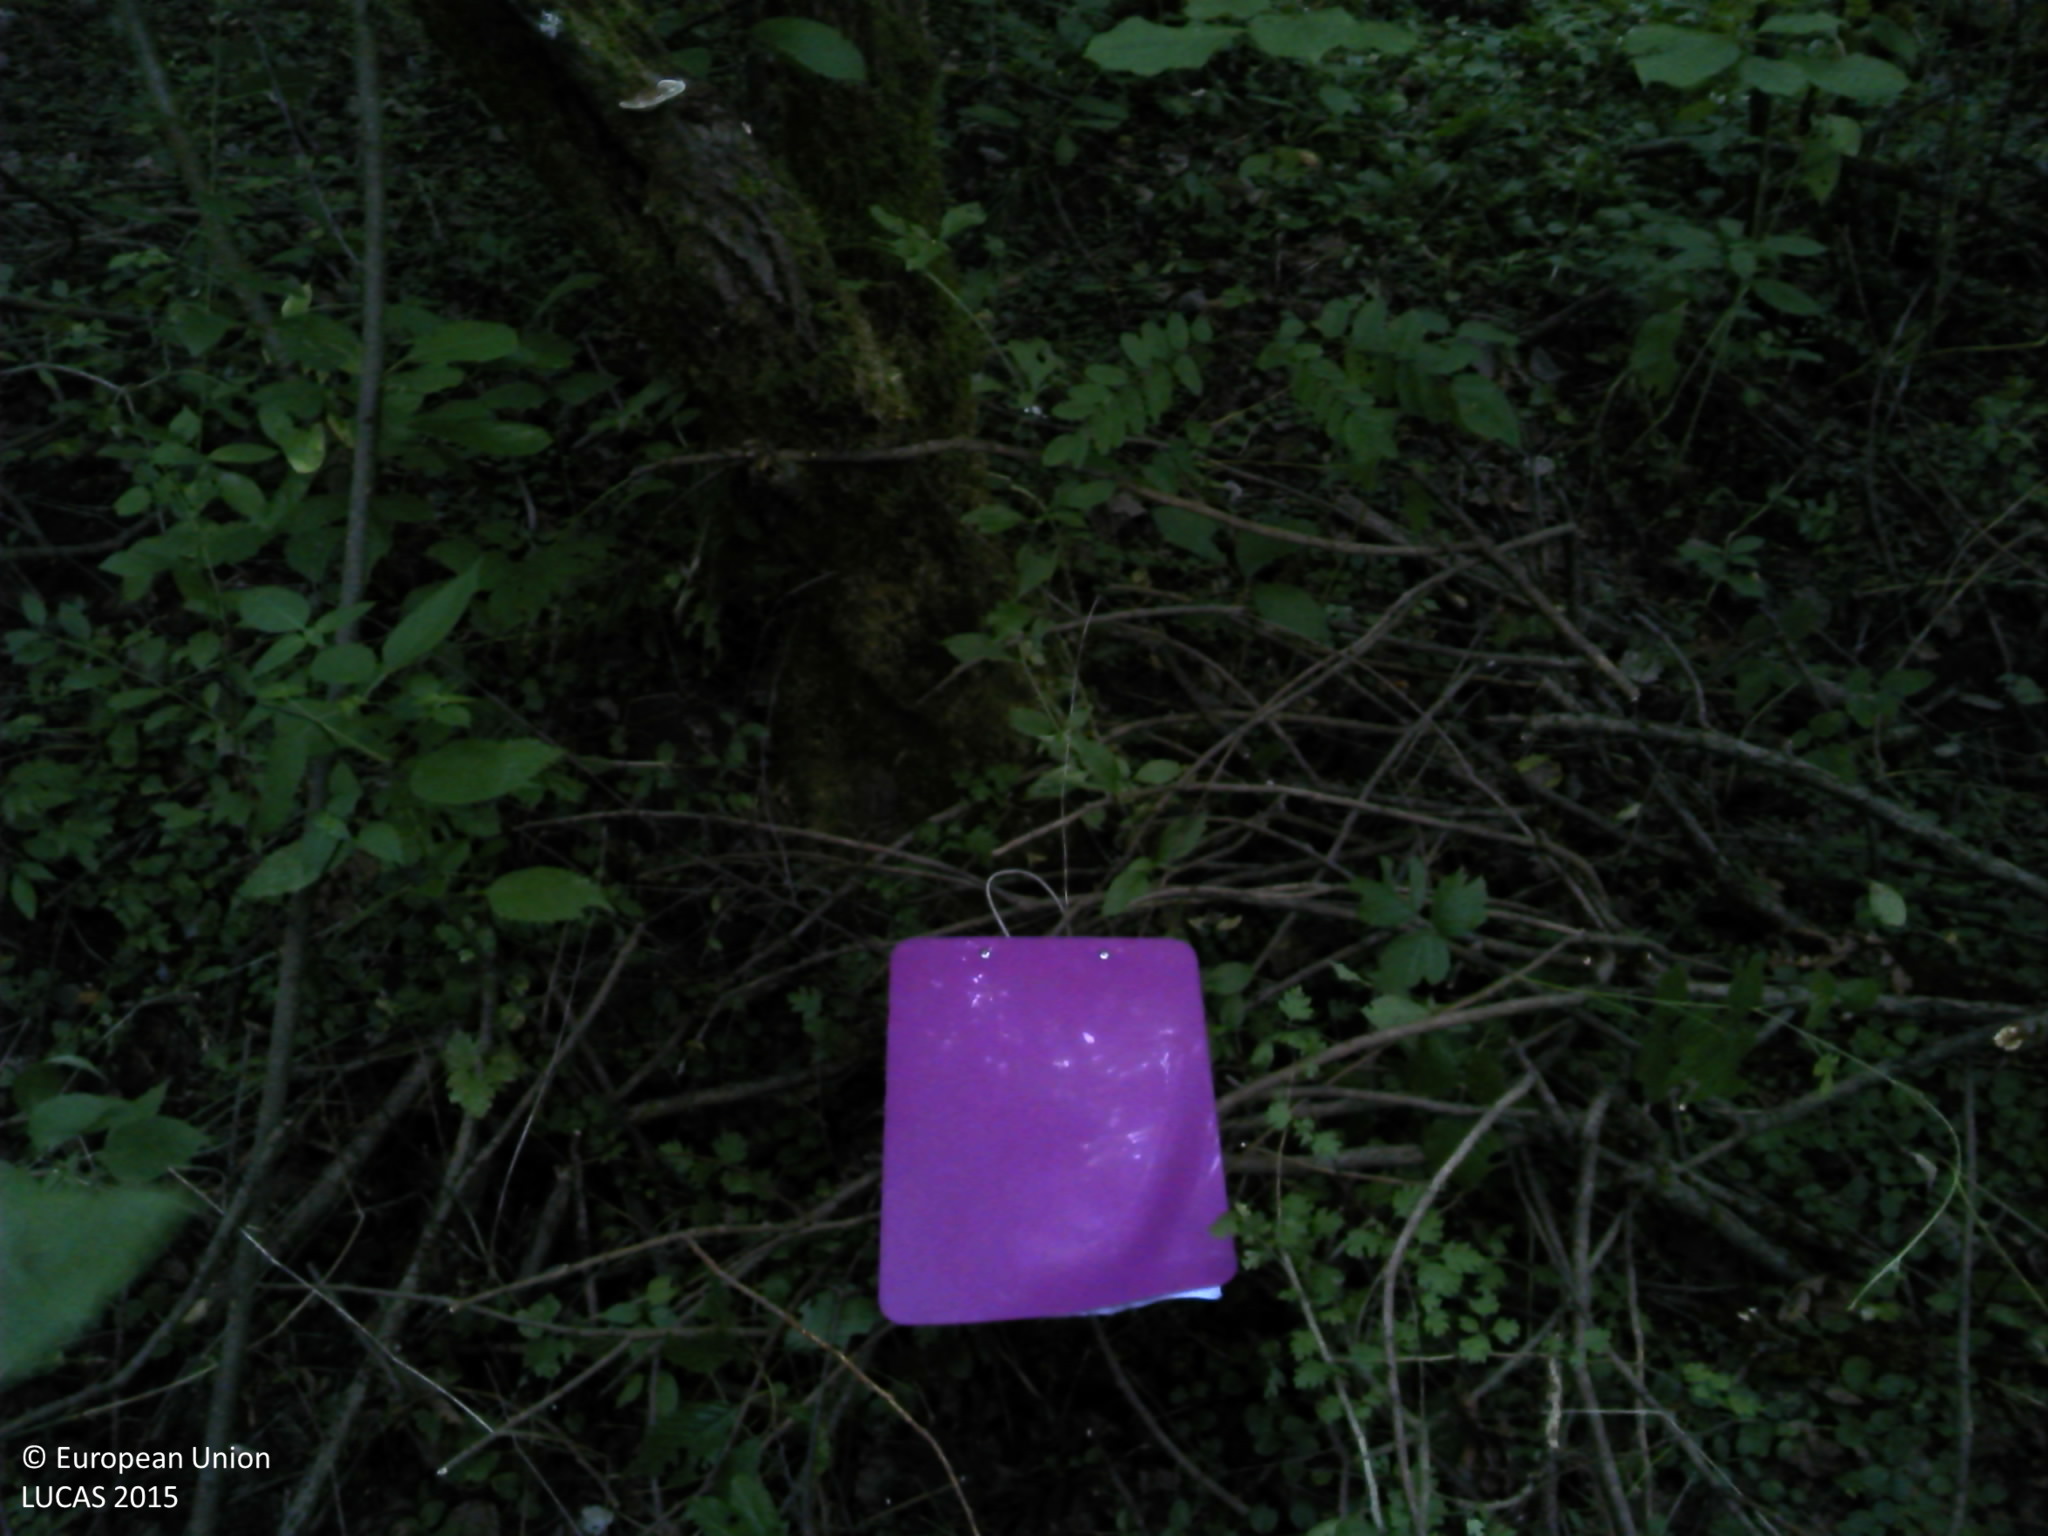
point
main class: Shrubland
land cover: Shrubland with sparse tree cover
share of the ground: > 75 %
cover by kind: shrubs 95 %, broadleaved forest trees 5 %
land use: Semi-natural and natural areas not in use
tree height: < 5 m
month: August
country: HR
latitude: 45.4288
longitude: 16.5294
